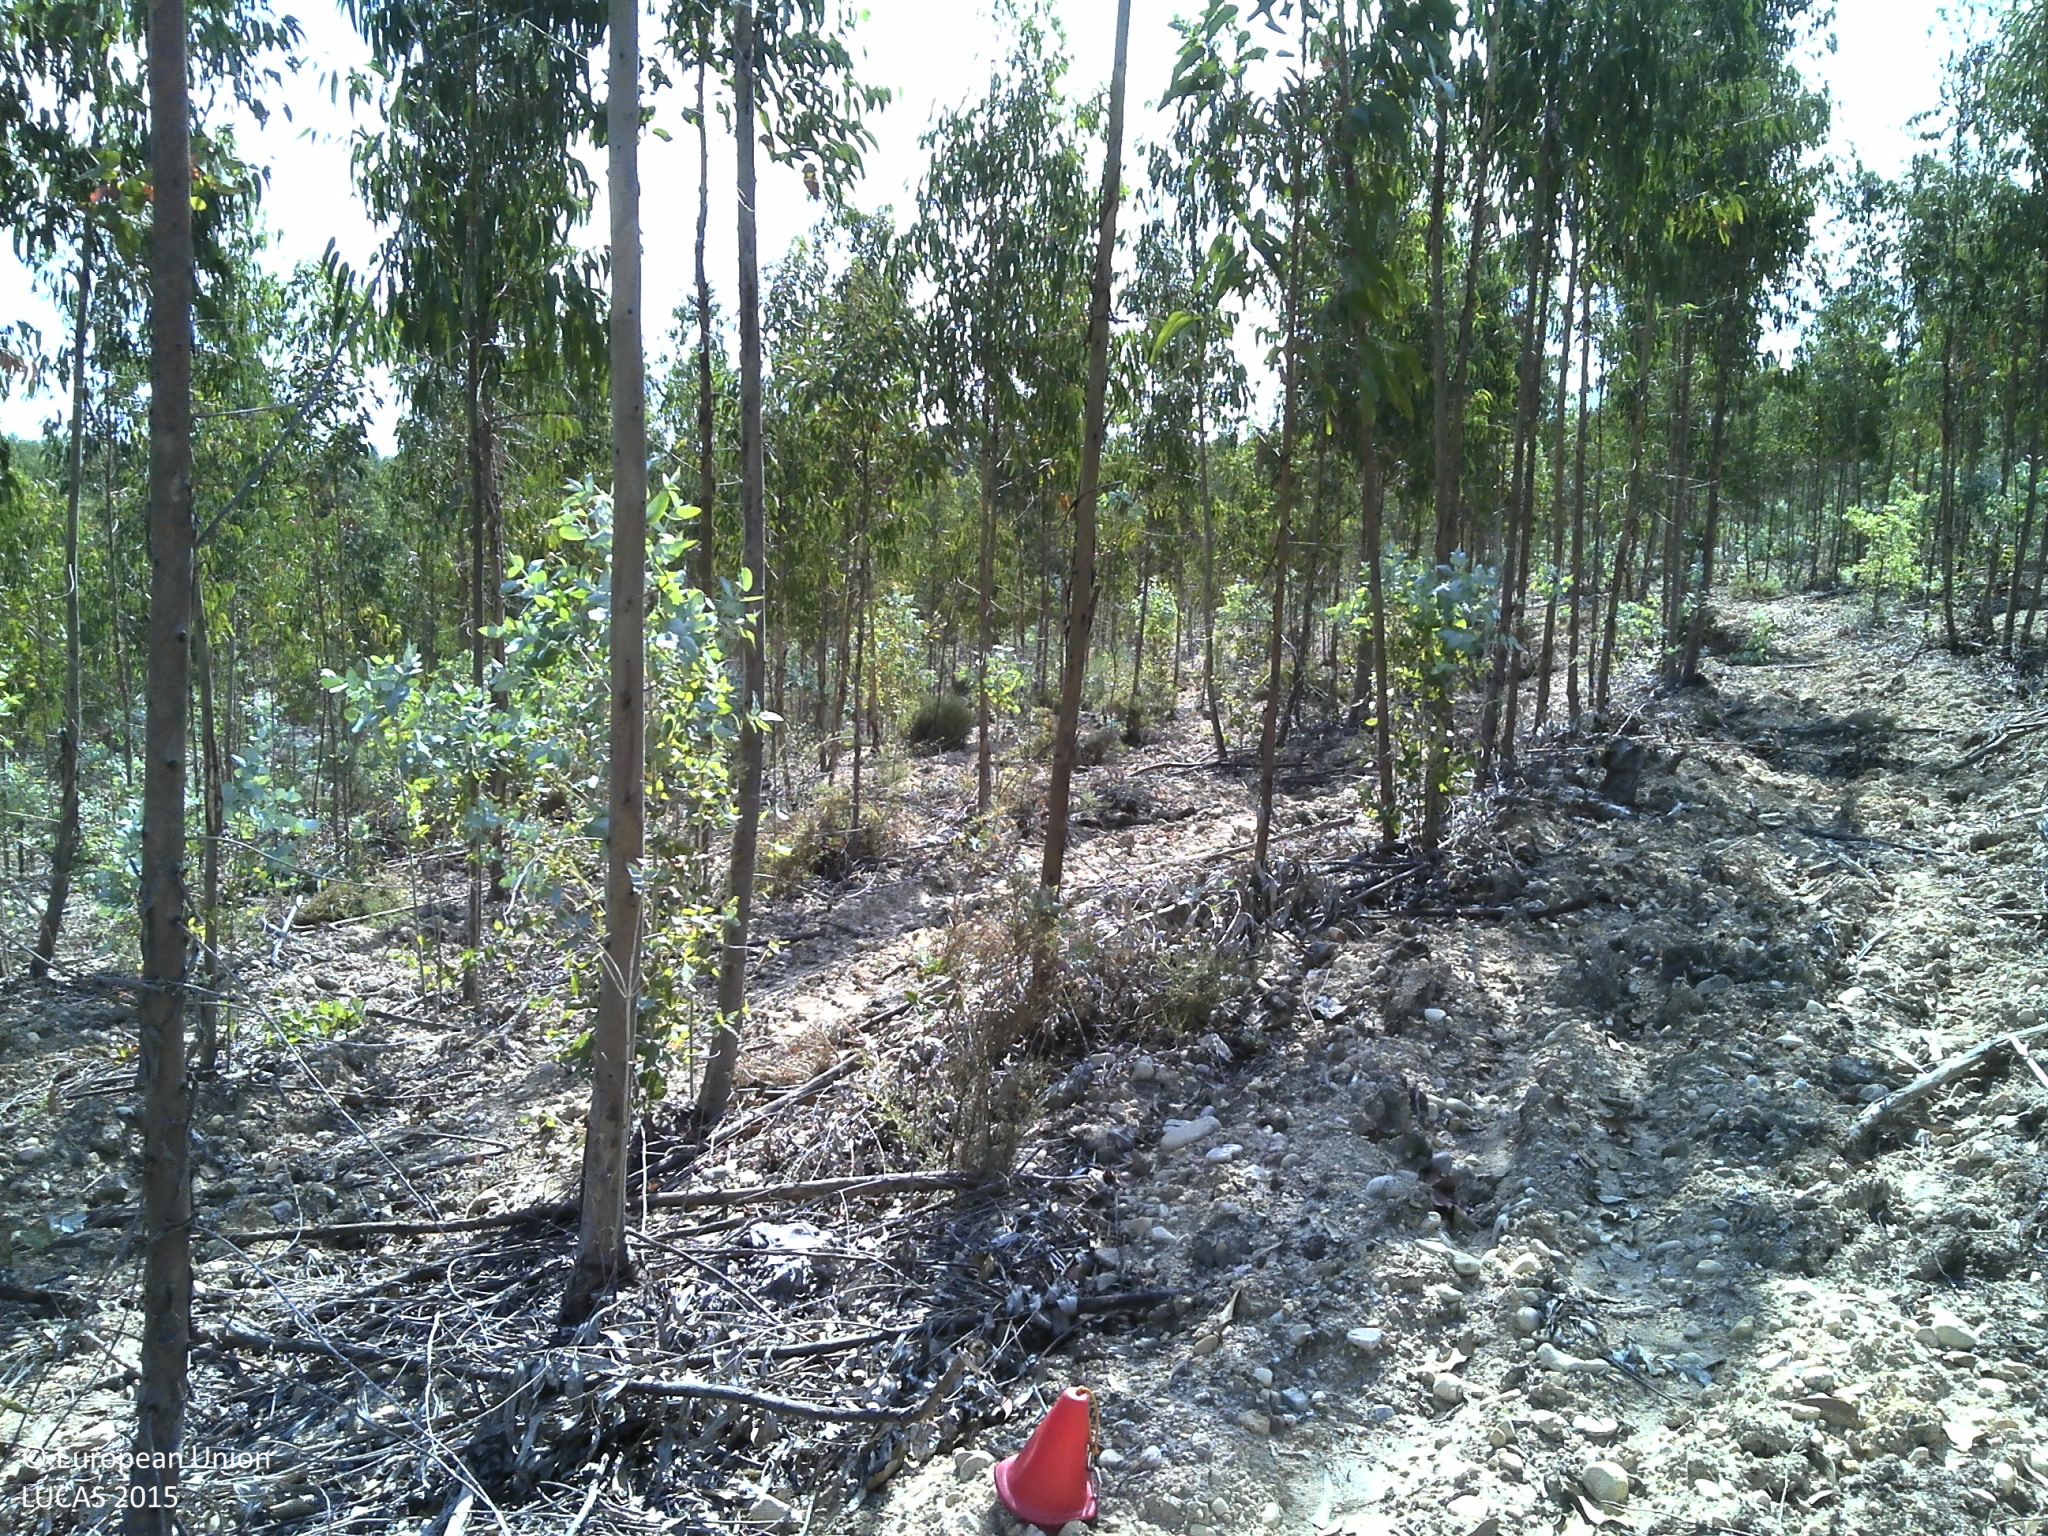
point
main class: Woodland
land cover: Broadleaved woodland
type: exotic forest
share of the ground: 50 - 75 %
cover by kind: broadleaved forest trees 50 %, unconsolidated bare surface 50 %
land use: Forestry
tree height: > 5 m
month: May
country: PT
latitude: 39.2776
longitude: -7.9640
